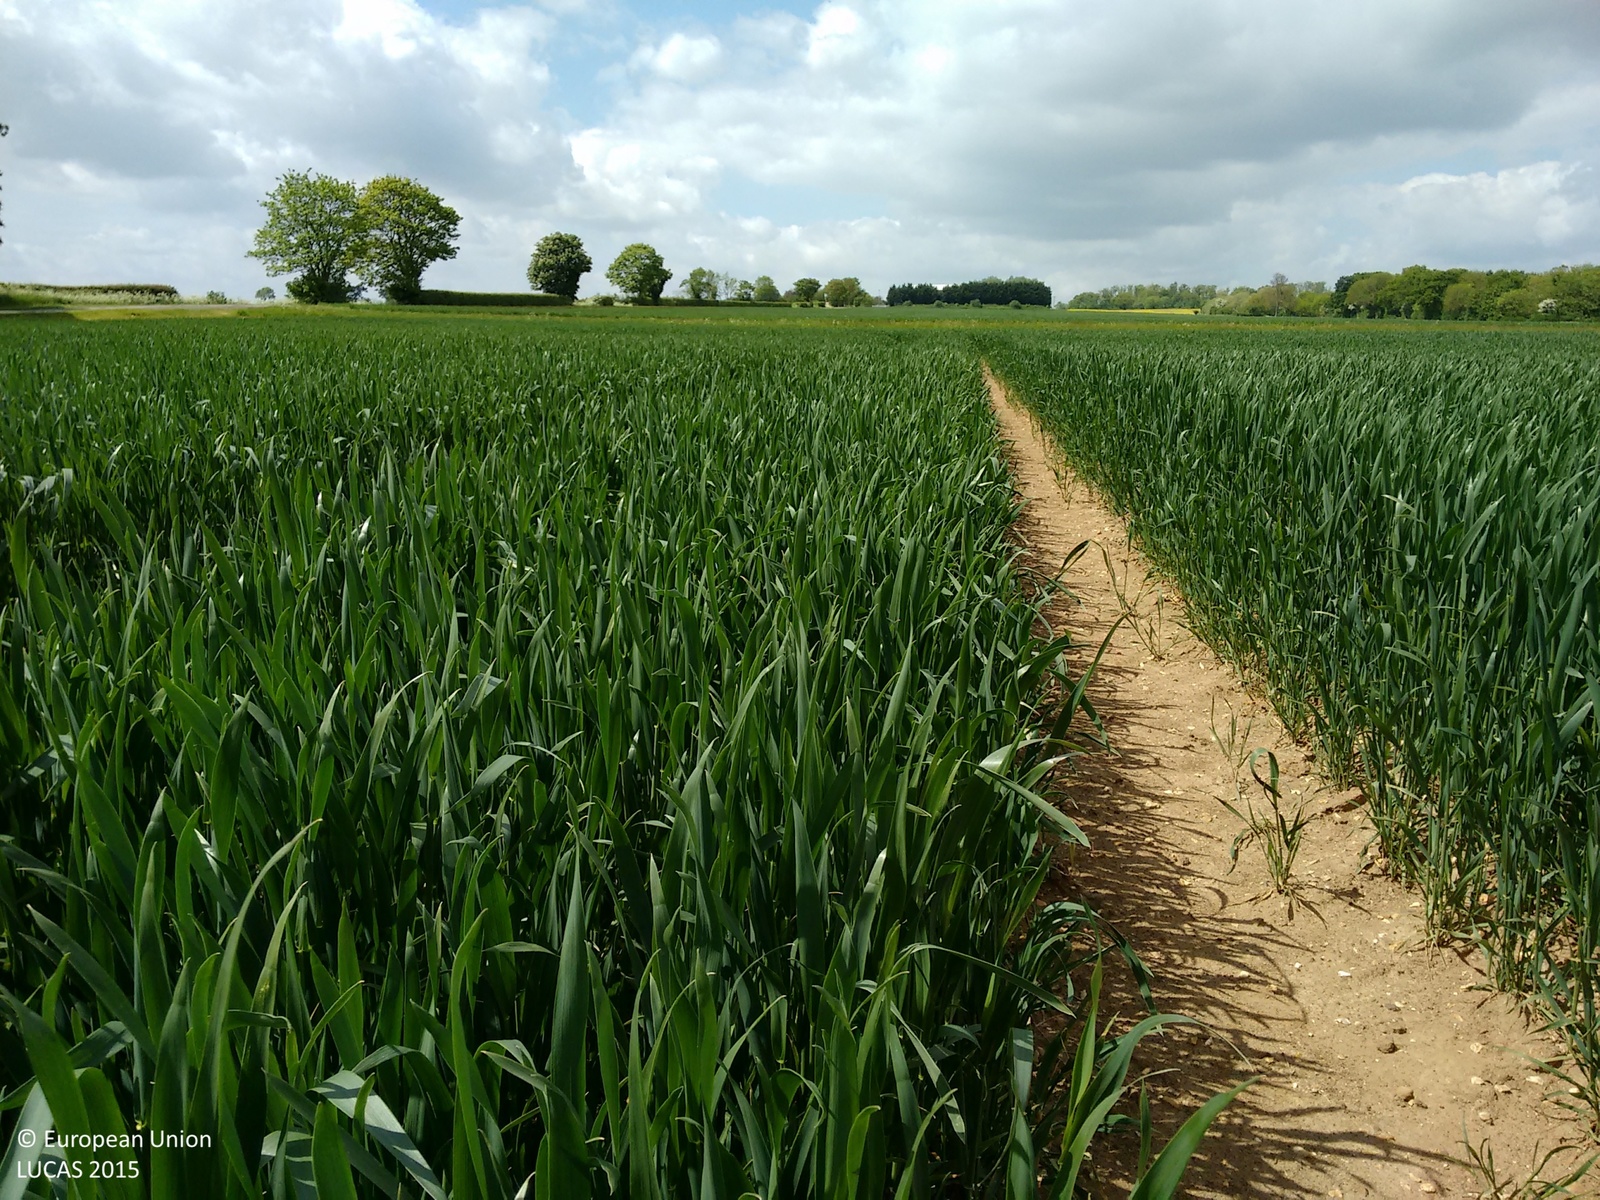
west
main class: Cropland
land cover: Common wheat
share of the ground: > 75 %
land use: Agriculture (excluding fallow land and kitchen gardens)
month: May
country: GB
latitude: 52.0536
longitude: -0.3174
